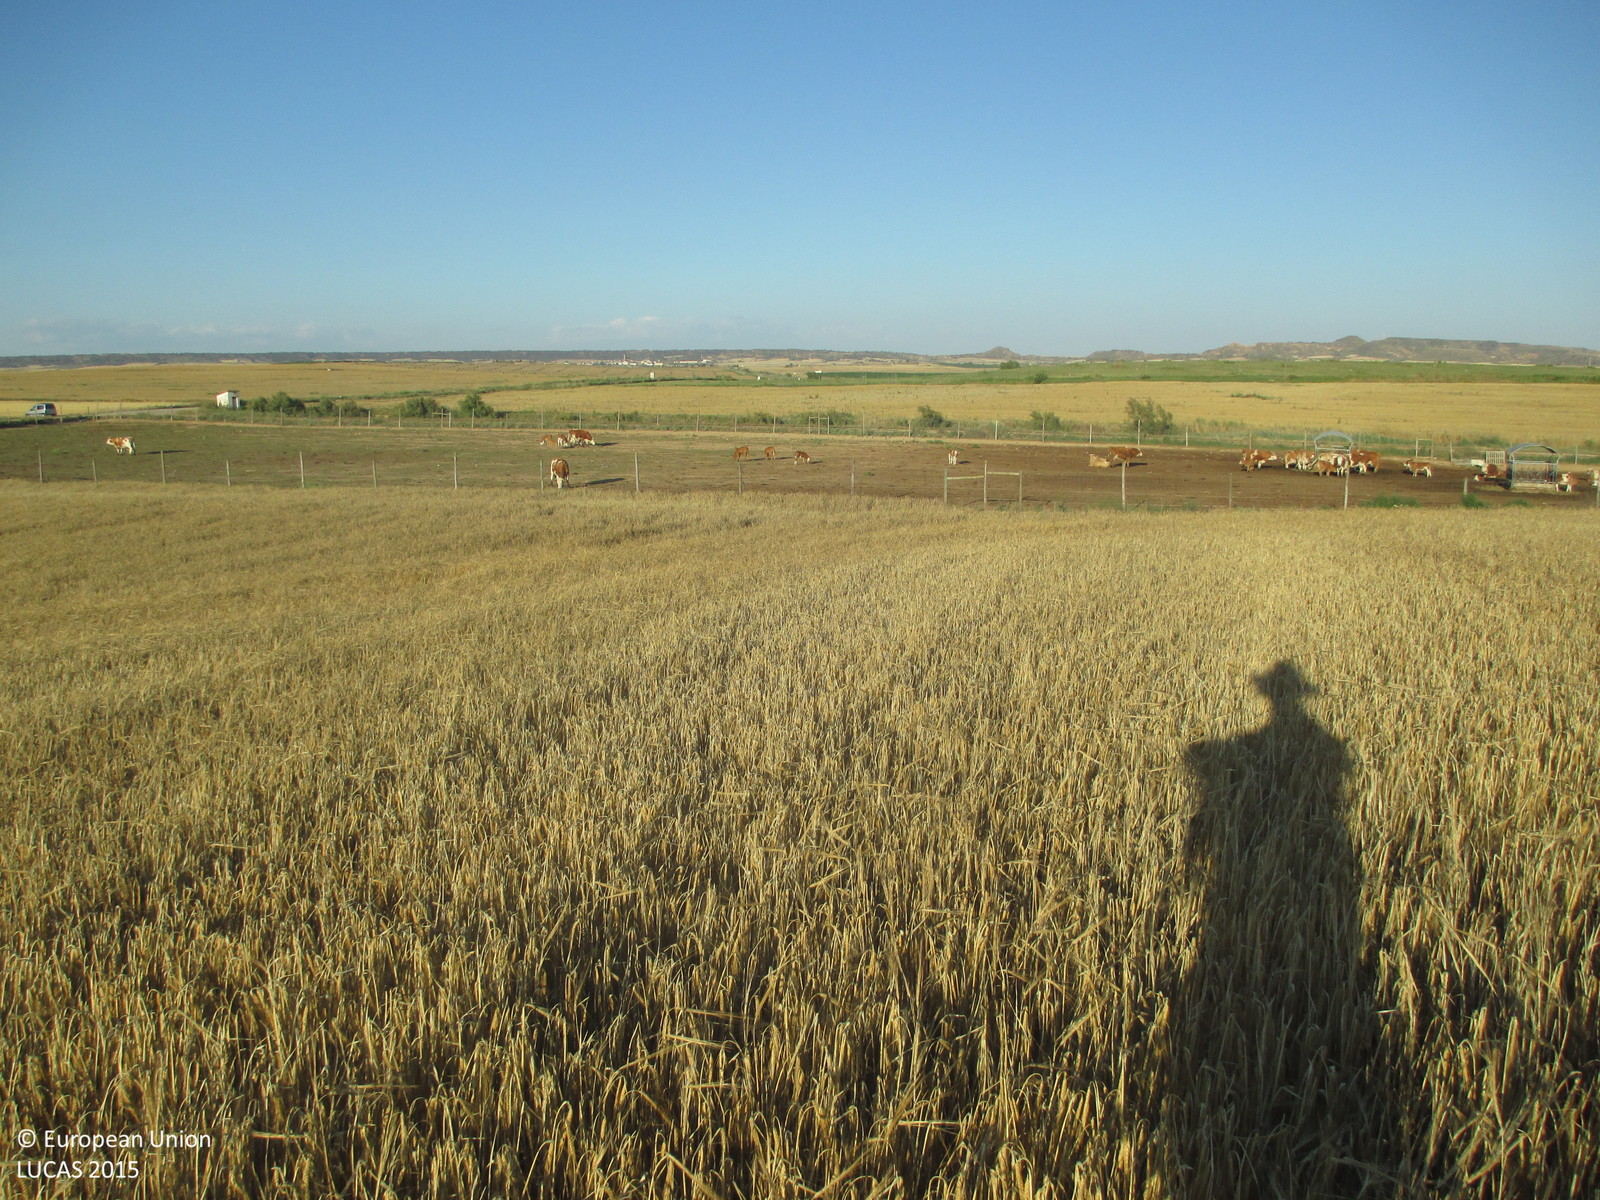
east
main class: Cropland
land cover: Barley
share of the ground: > 75 %
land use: Agriculture (excluding fallow land and kitchen gardens)
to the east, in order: Barley; Fences; Grassland without tree/shrub cover; Fences; Shruby margins; Tracks; Spontaneously vegetated surfaces; Inland fresh running water; Grassland with sparse tree/shrub cover; Tracks; Shruby margins; Barley
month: June
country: ES
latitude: 42.0445
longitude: -0.3995
